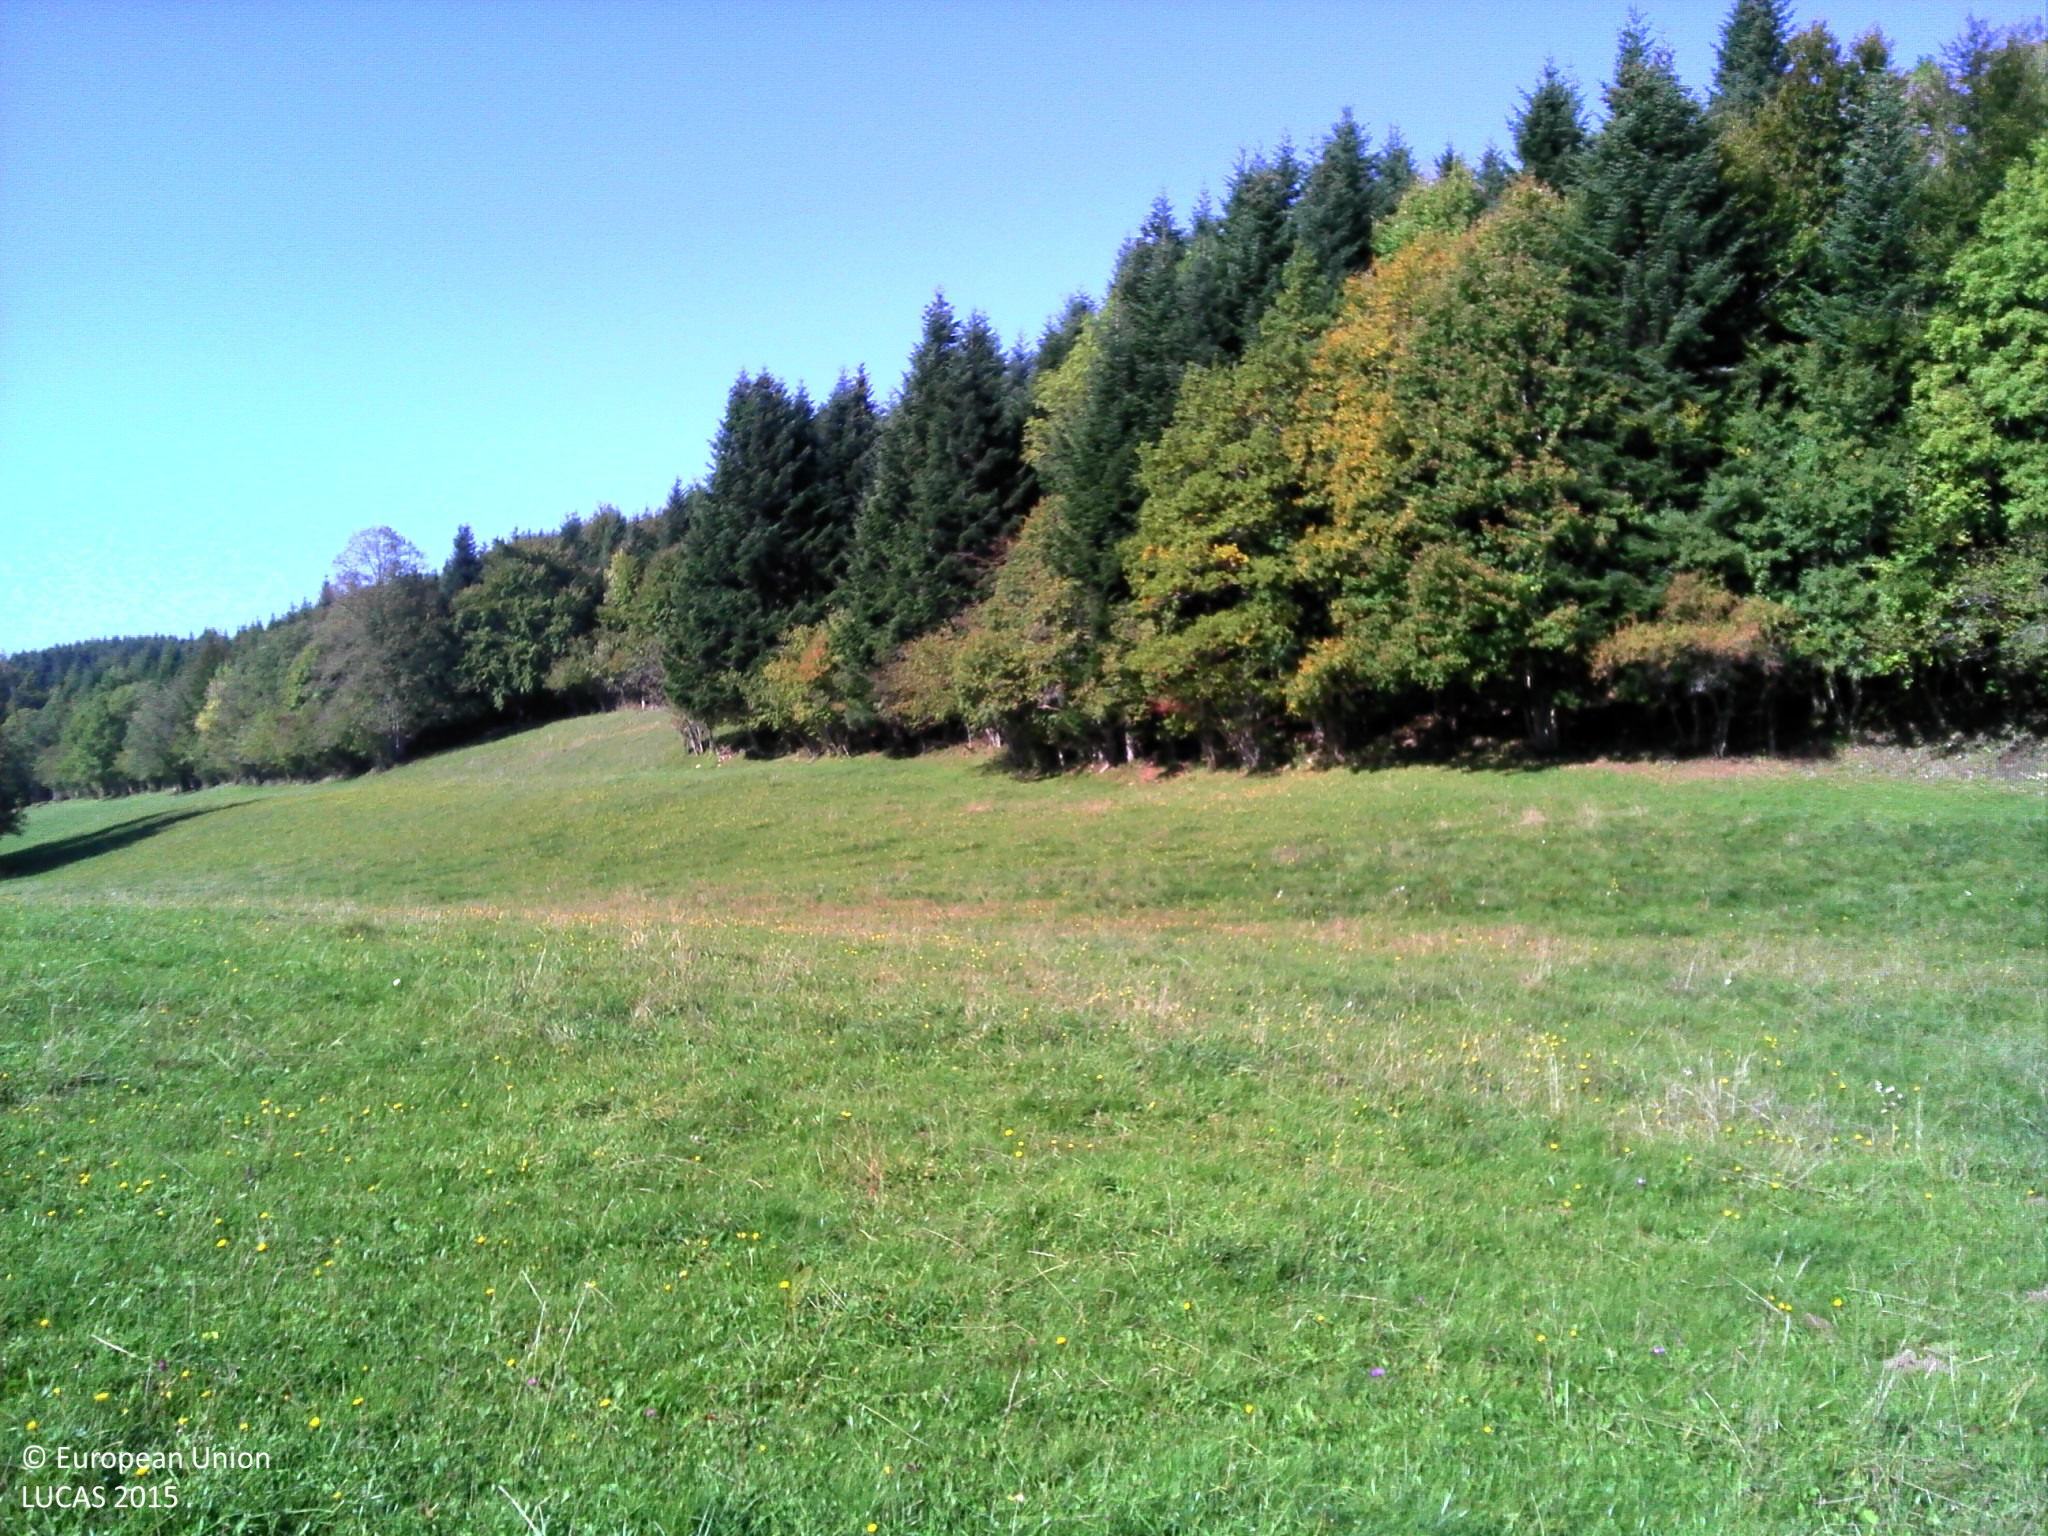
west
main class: Grassland
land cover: Grassland without tree/shrub cover
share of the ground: > 75 %
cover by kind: herbaceous plants 100 %
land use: Agriculture (excluding fallow land and kitchen gardens)
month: September
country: FR
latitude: 47.0831
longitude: 6.3800
